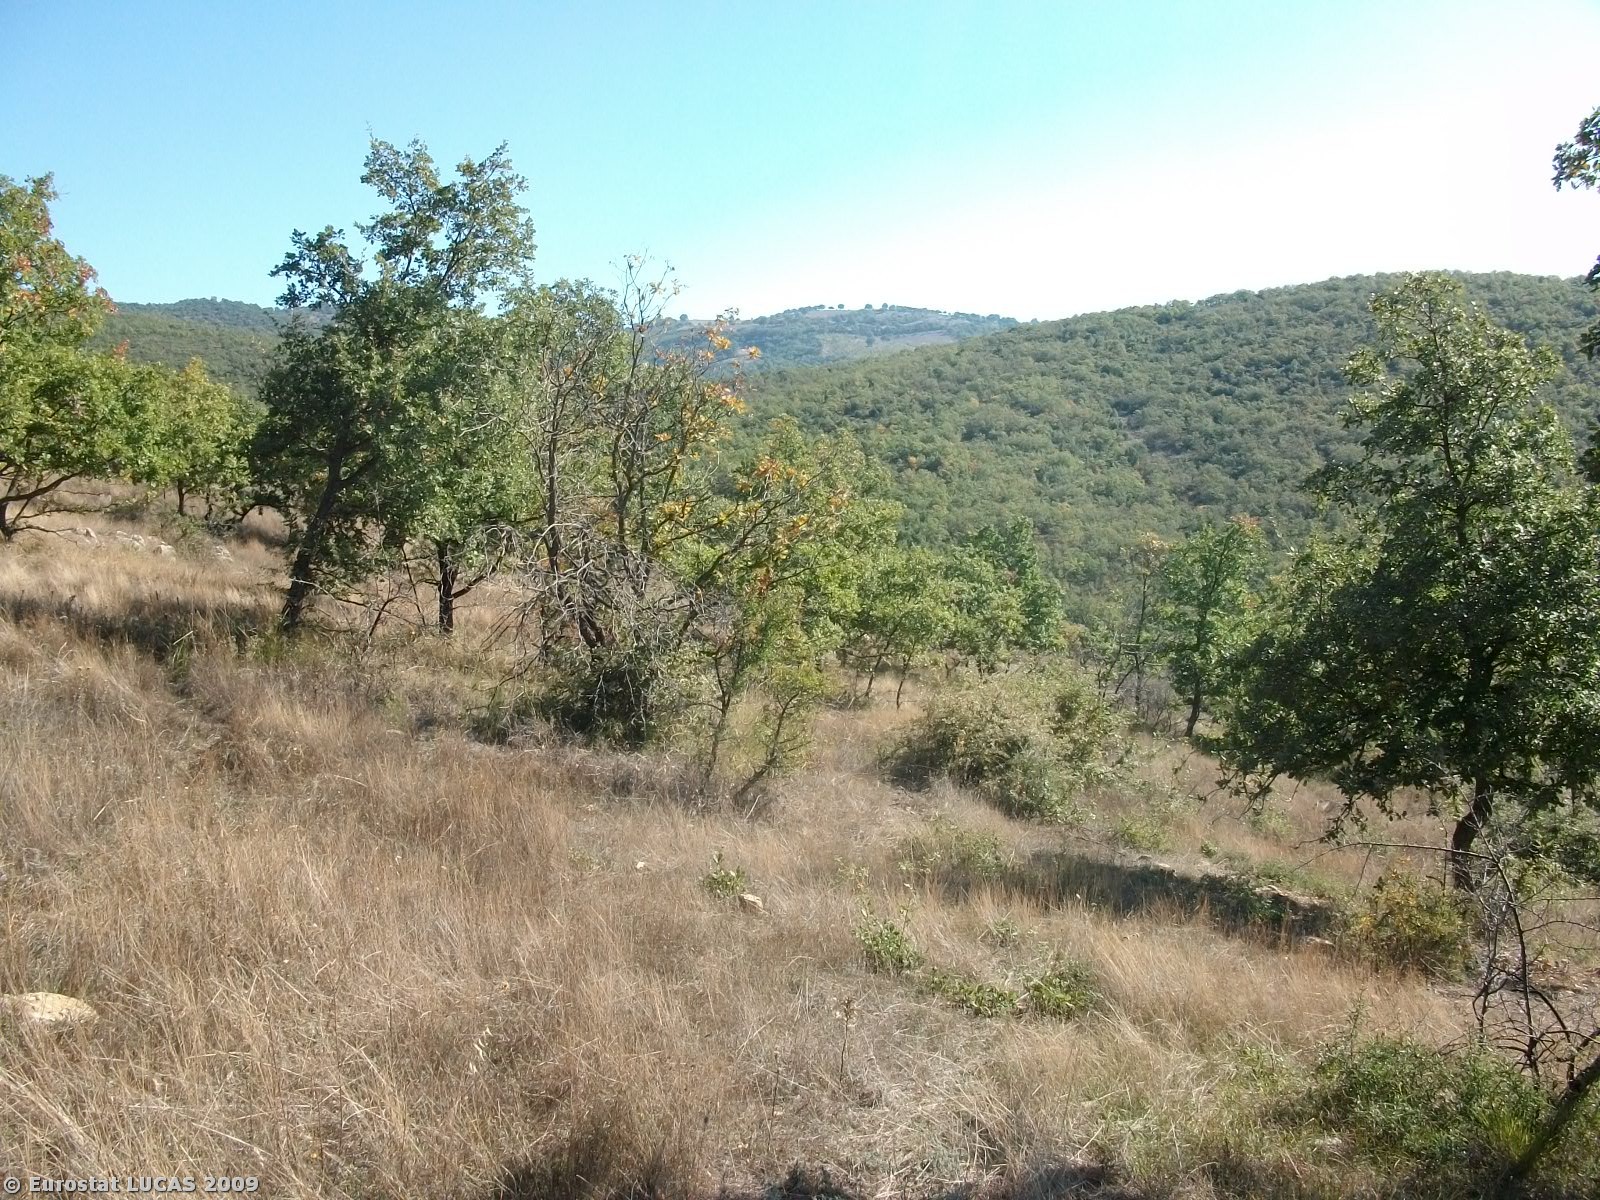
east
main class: Woodland
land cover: Broadleaved woodland
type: thermophilous deciduous forest
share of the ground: 25 - 50 %
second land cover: Grassland with sparse tree/shrub cover
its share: > 75 %
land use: Forestry
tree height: > 5 m
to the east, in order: Broadleaved woodland; Grassland with sparse tree/shrub cover; Ditches and canals; Grassland with sparse tree/shrub cover; Clovers; Electric lines; Abandoned hedges; Paved roads, cycling and walking lanes; Shrubland without tree cover
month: October
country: GR
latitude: 39.0829
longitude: 22.4800
